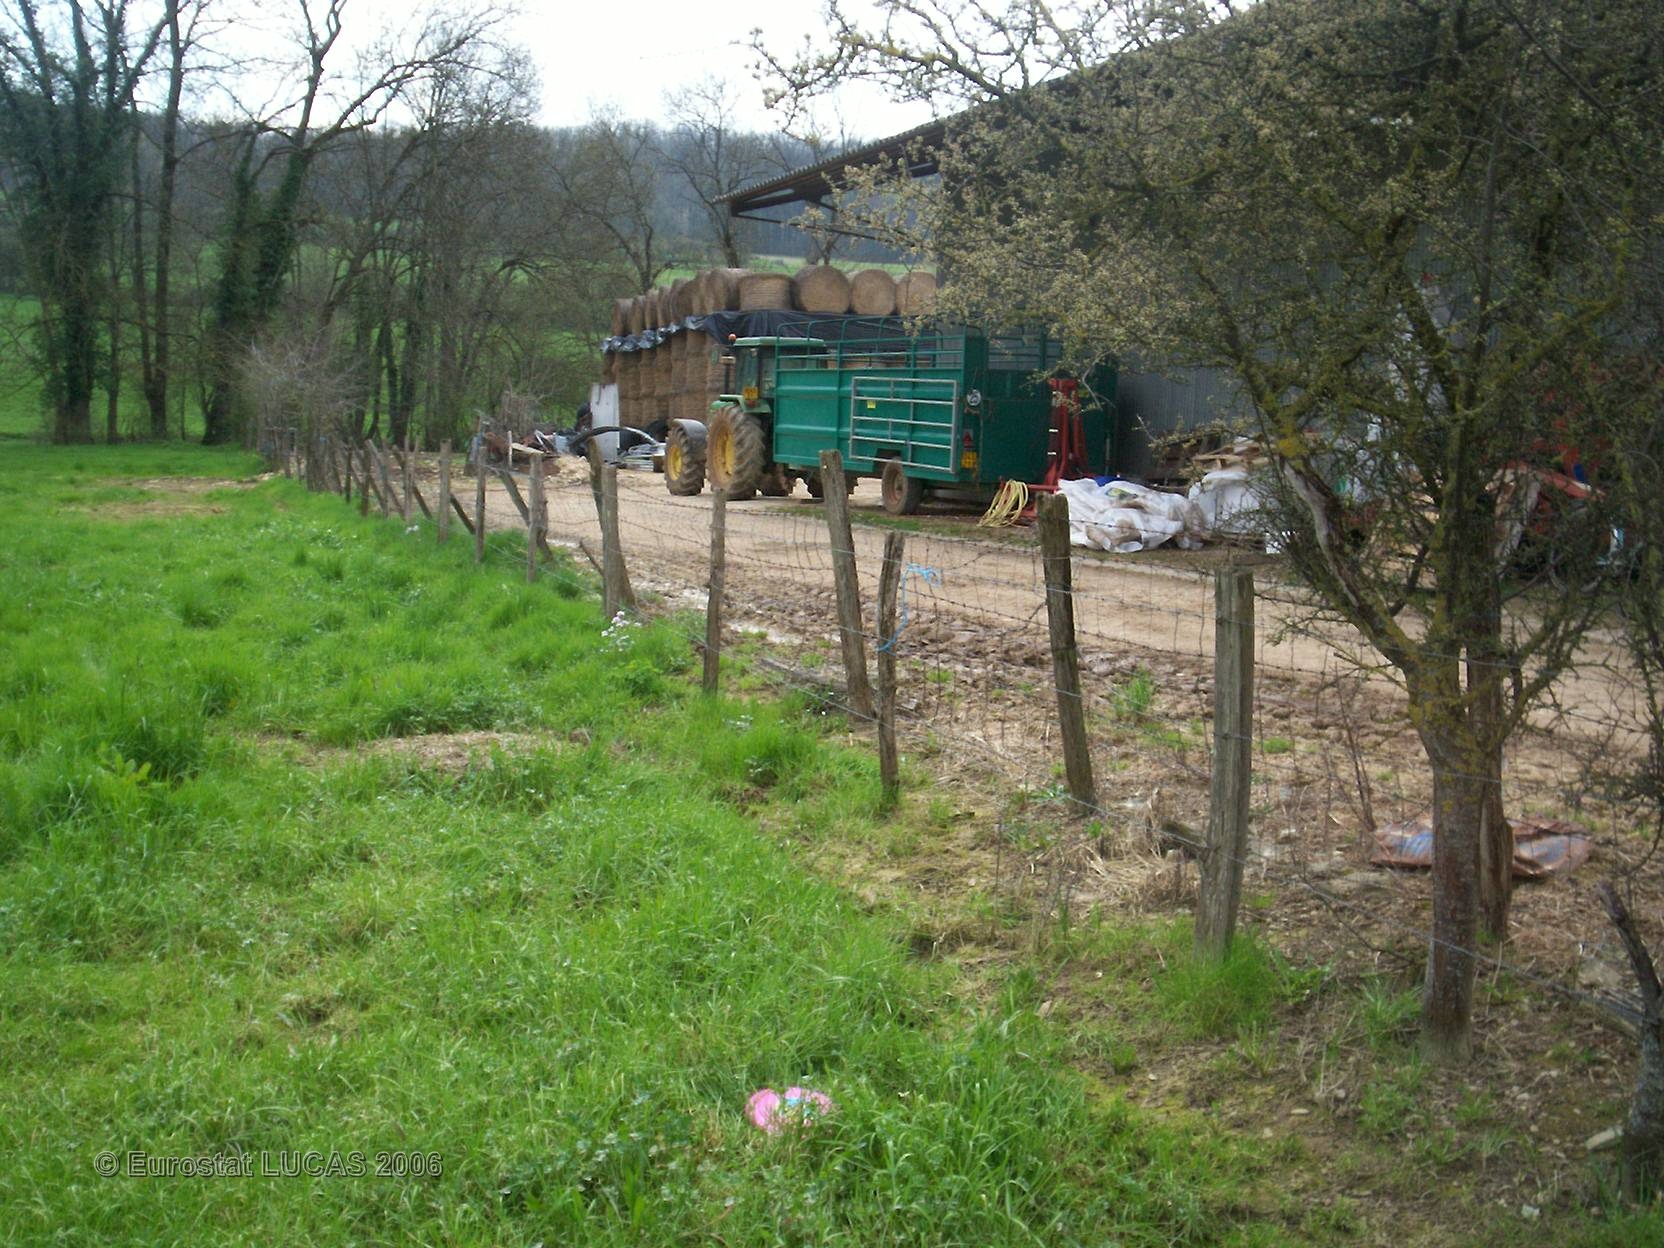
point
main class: Grassland
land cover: Grassland without tree/shrub cover
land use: Agriculture (excluding fallow land and kitchen gardens)
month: April
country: FR
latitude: 47.5484
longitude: 4.5646
